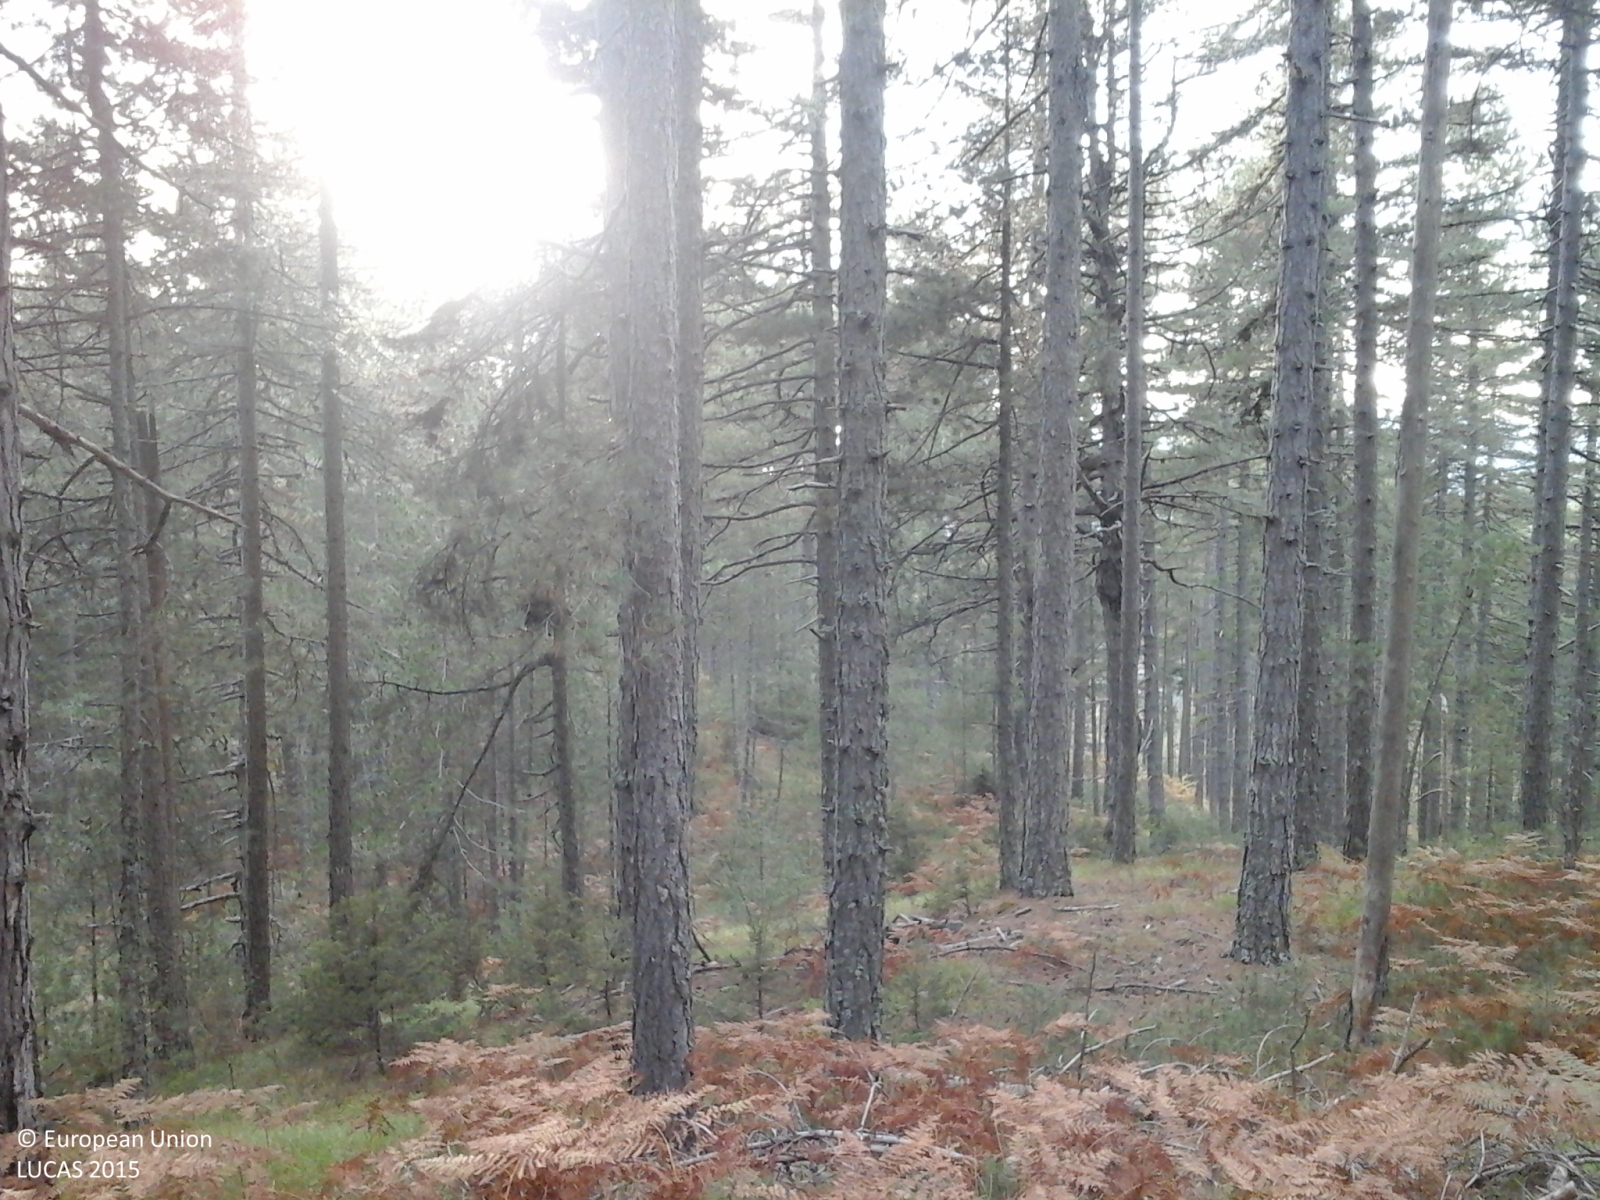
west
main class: Woodland
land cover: Pine dominated coniferous woodland
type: coniferous forest of the mediterranean region
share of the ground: 50 - 75 %
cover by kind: coniferous forest trees 70 %, herbaceous plants 20 %, shrubs 5 %, unconsolidated bare surface 5 %
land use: Forestry
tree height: > 5 m
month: October
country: GR
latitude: 39.8473
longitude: 21.0024
